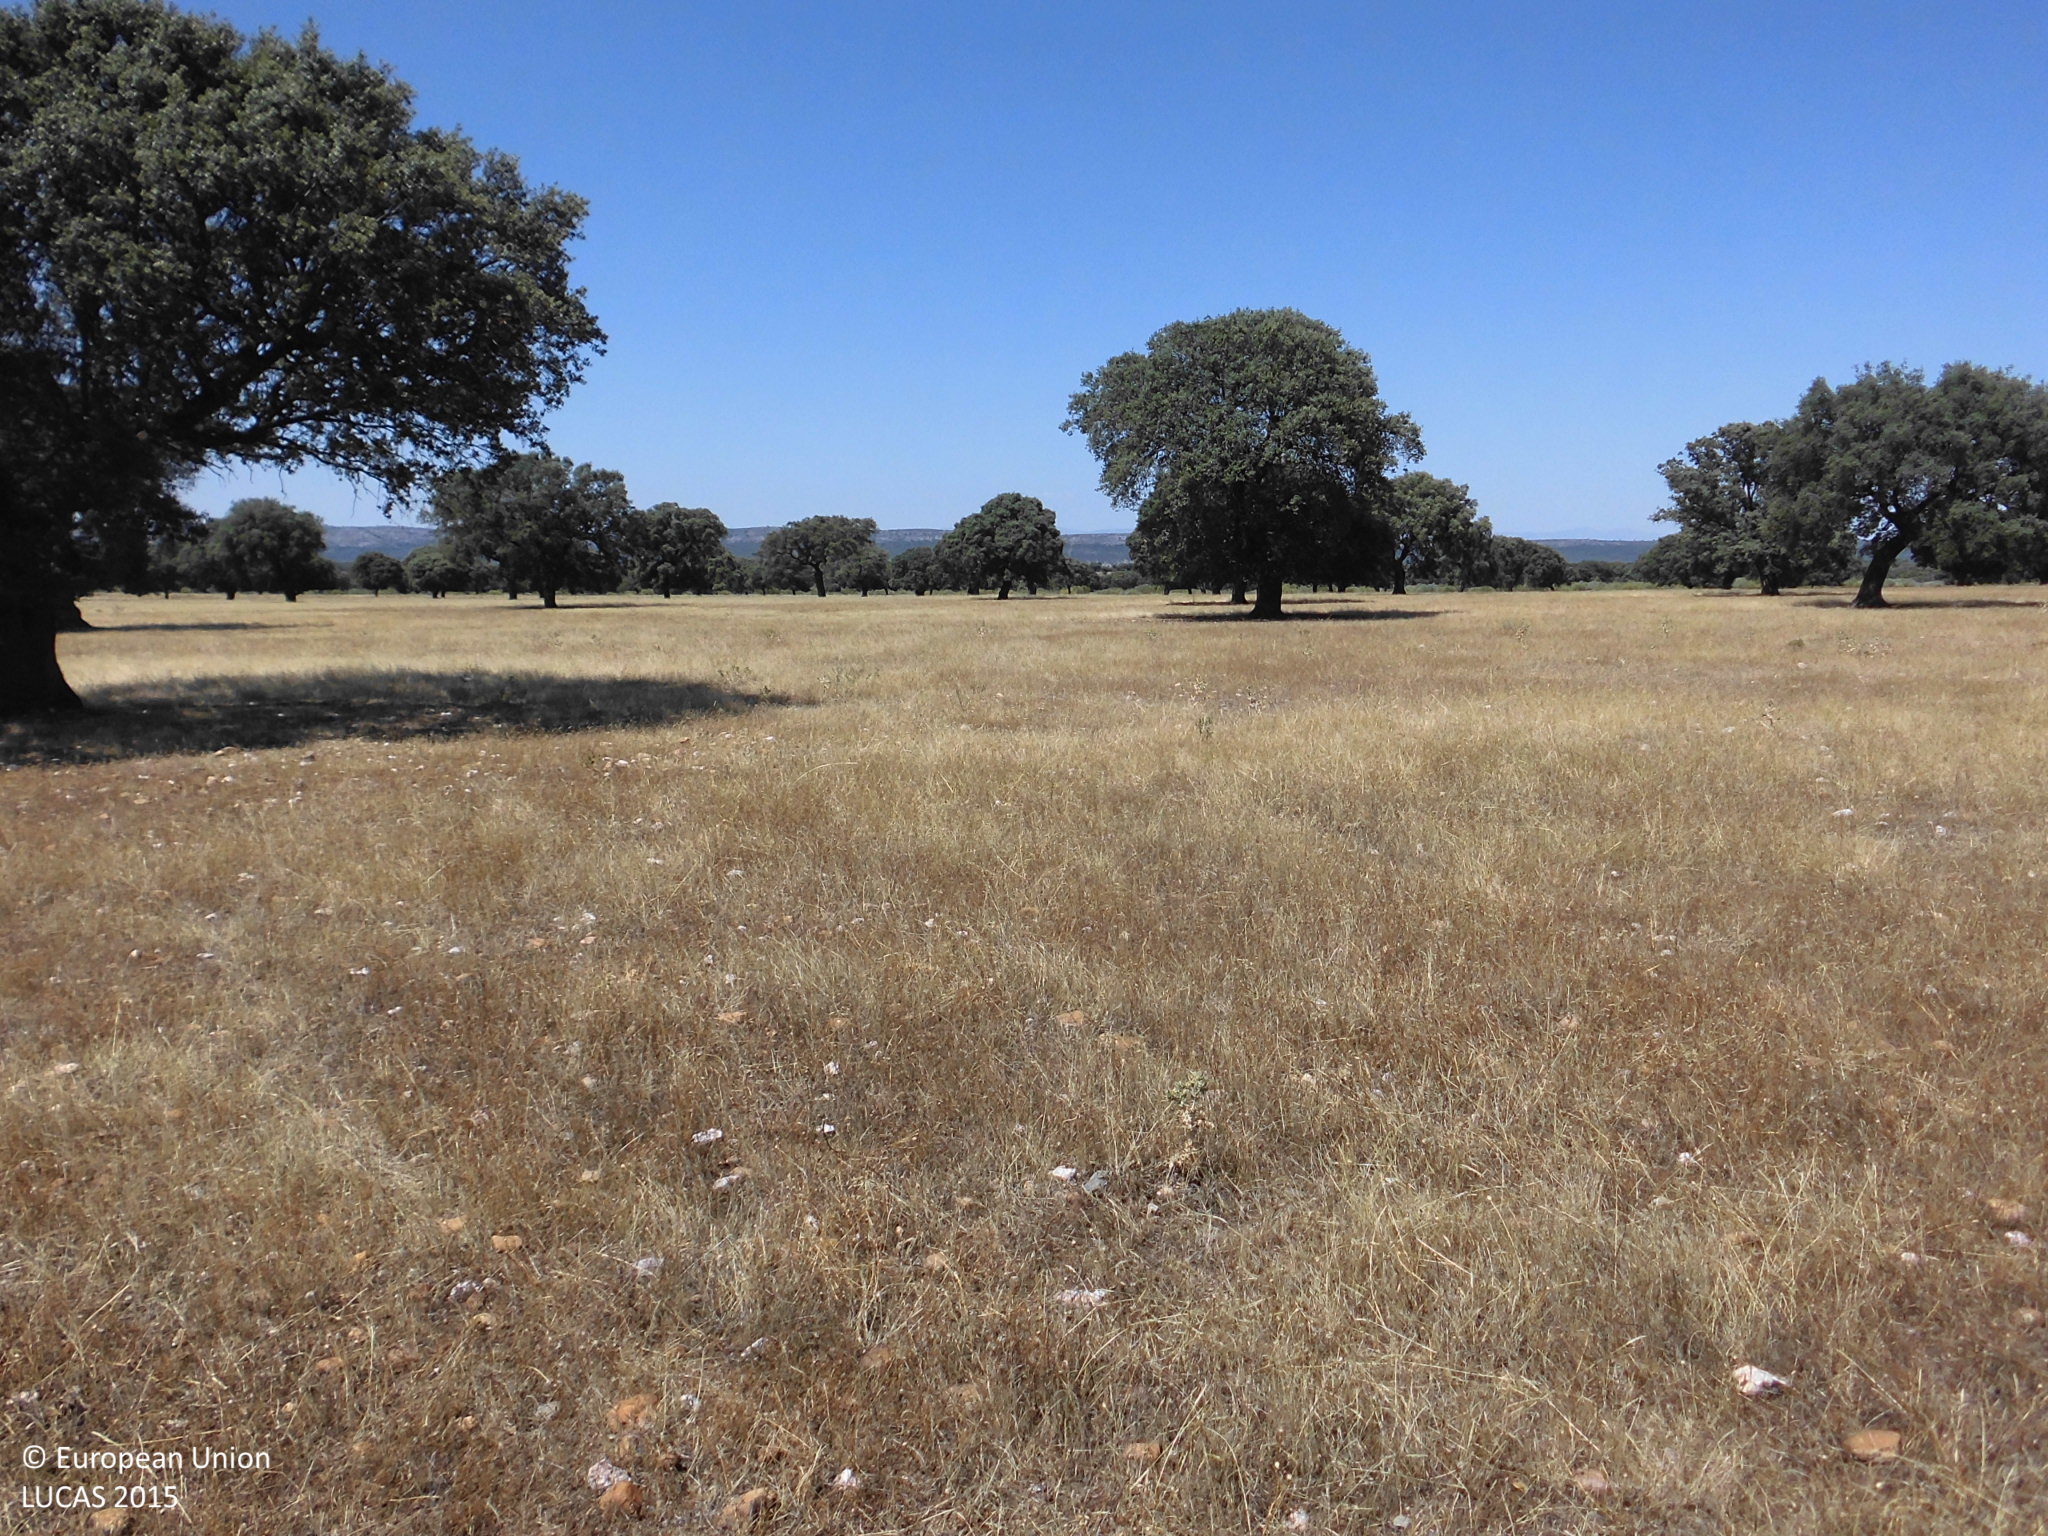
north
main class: Grassland
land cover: Grassland with sparse tree/shrub cover
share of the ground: > 75 %
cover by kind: herbaceous plants 95 %, broadleaved forest trees 5 %
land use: Agriculture (excluding fallow land and kitchen gardens)
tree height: > 5 m
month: June
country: ES
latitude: 39.7410
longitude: -5.9697
